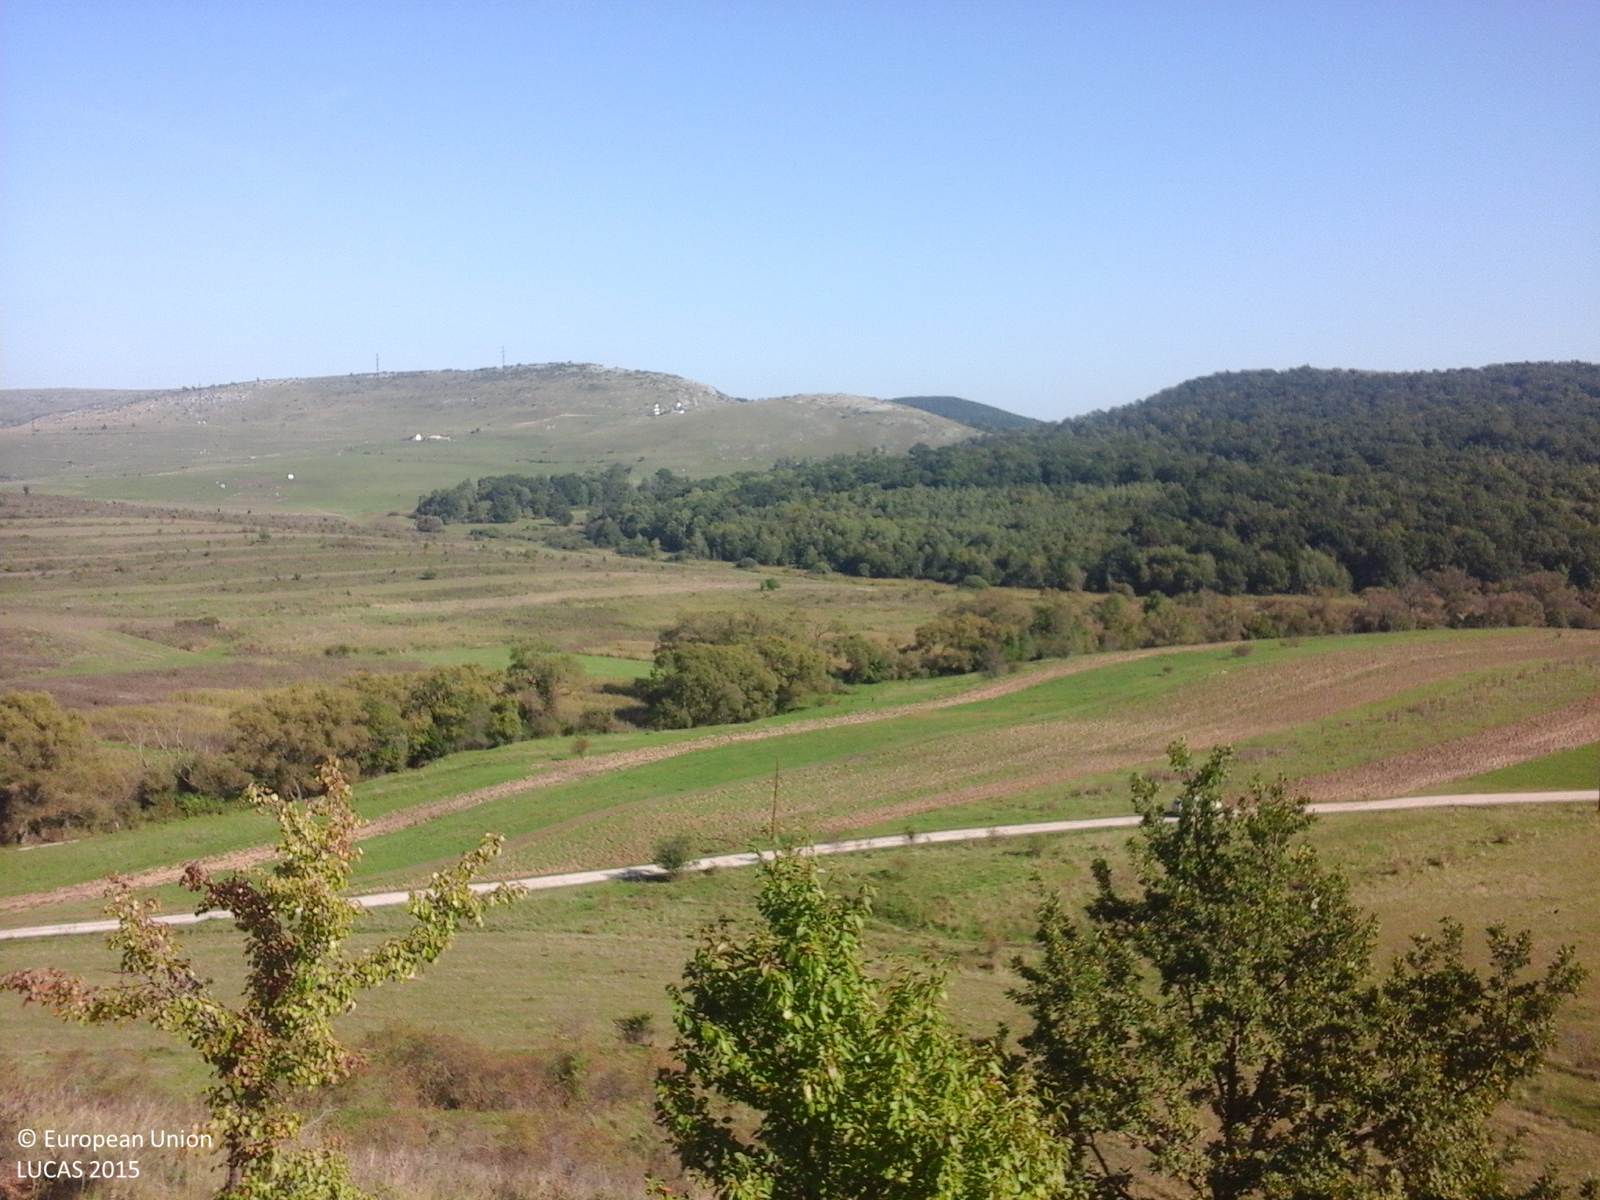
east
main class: Grassland
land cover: Grassland with sparse tree/shrub cover
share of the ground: > 75 %
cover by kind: herbaceous plants 85 %, shrubs 10 %, broadleaved forest trees 5 %
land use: Fallow land
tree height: < 5 m
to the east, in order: Grassland with sparse tree/shrub cover; Grassland without tree/shrub cover; Grassland with sparse tree/shrub cover; Ditches and canals; Grassland with sparse tree/shrub cover; Ditches and canals; Grass margins; Tracks; Grass margins; Electric lines; Grassland without tree/shrub cover; Other bare soil; Tracks; Grassland without tree/shrub cover; Other bare soil; Grassland without tree/shrub cover
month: October
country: RO
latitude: 46.5343
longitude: 23.6169
